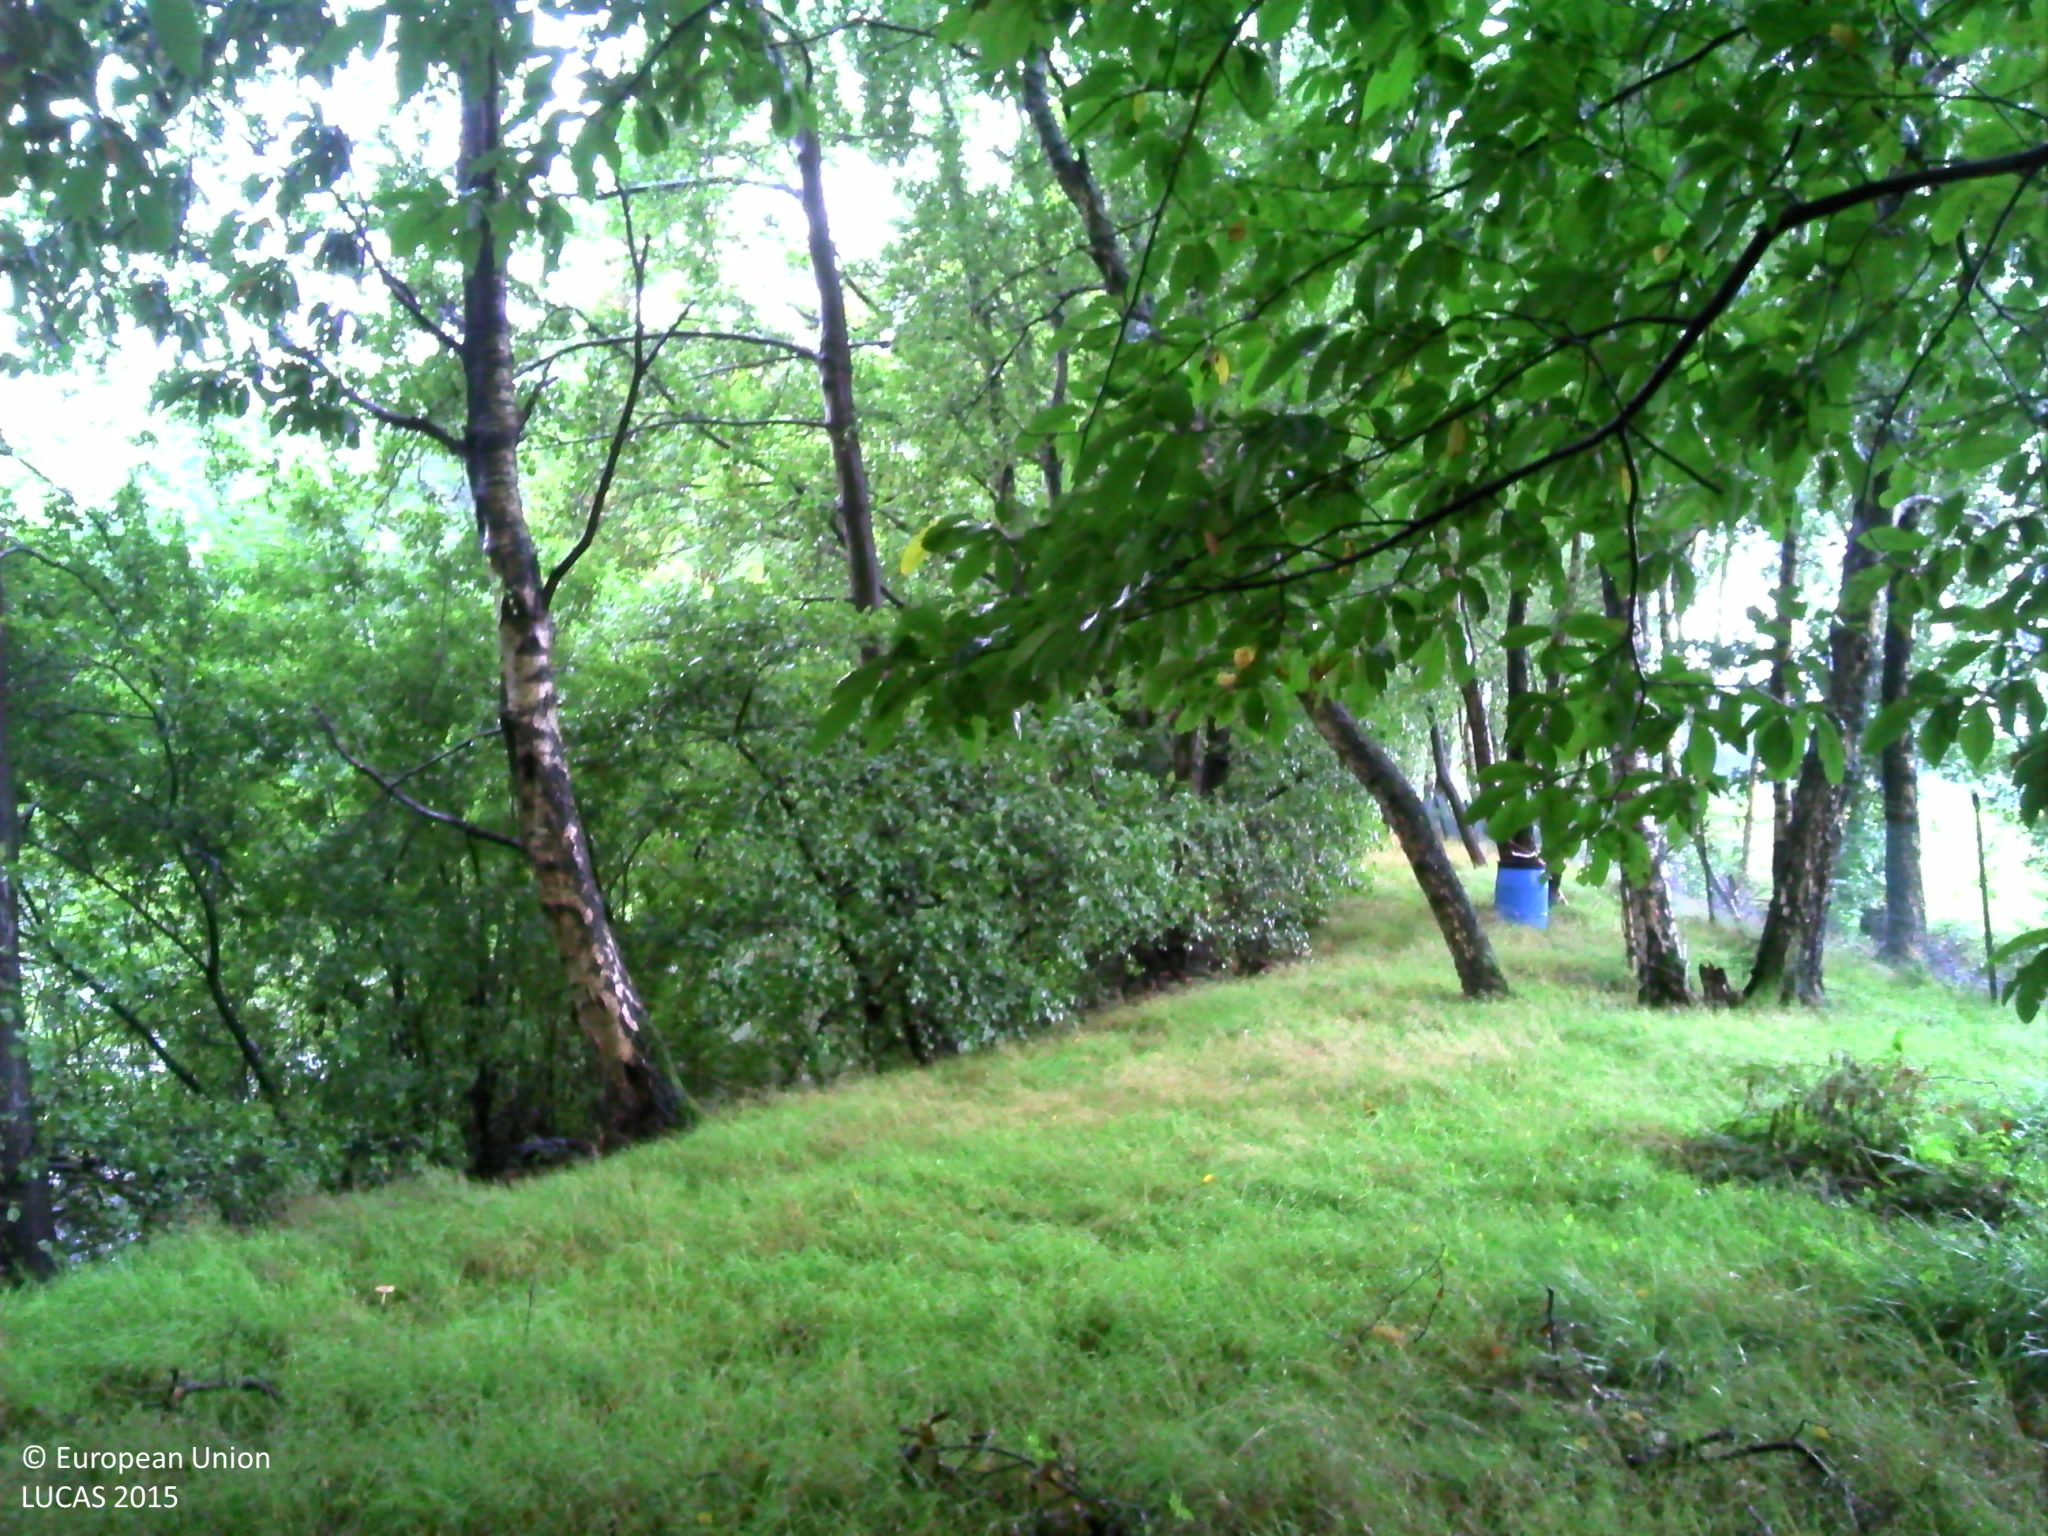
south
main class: Woodland
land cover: Broadleaved woodland
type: floodplain forest
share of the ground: > 75 %
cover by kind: broadleaved forest trees 80 %, herbaceous plants 20 %
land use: Forestry
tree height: > 5 m
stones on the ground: < 10 %
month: September
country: BE
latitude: 51.3416
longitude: 4.7279
